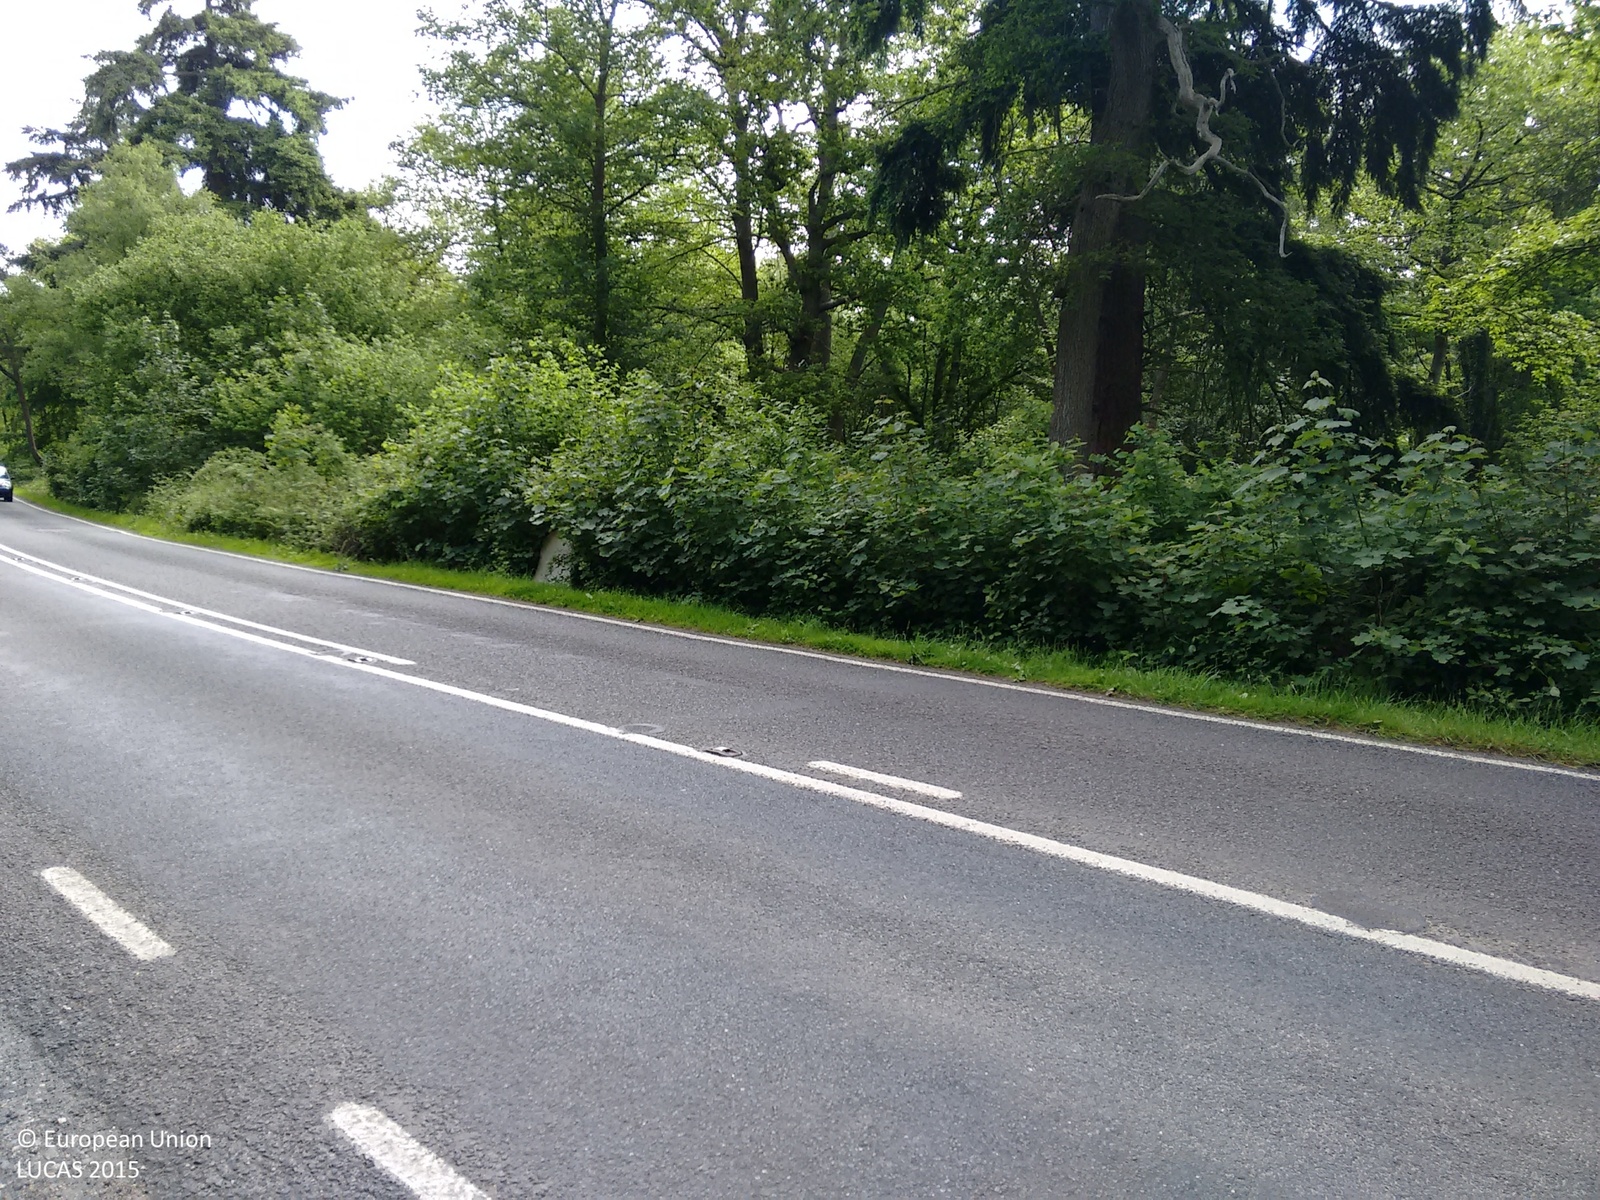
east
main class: Woodland
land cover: Broadleaved woodland
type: mesophytic deciduous forest
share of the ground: > 75 %
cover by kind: broadleaved forest trees 90 %, coniferous forest trees 10 %
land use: Forestry
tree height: > 5 m
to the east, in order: Broadleaved woodland; Paved roads, cycling and walking lanes; Grass margins; Broadleaved woodland; Ditches and canals; Other coniferous woodland; Tracks; Other coniferous woodland
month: May
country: GB
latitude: 50.8718
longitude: -0.9430
